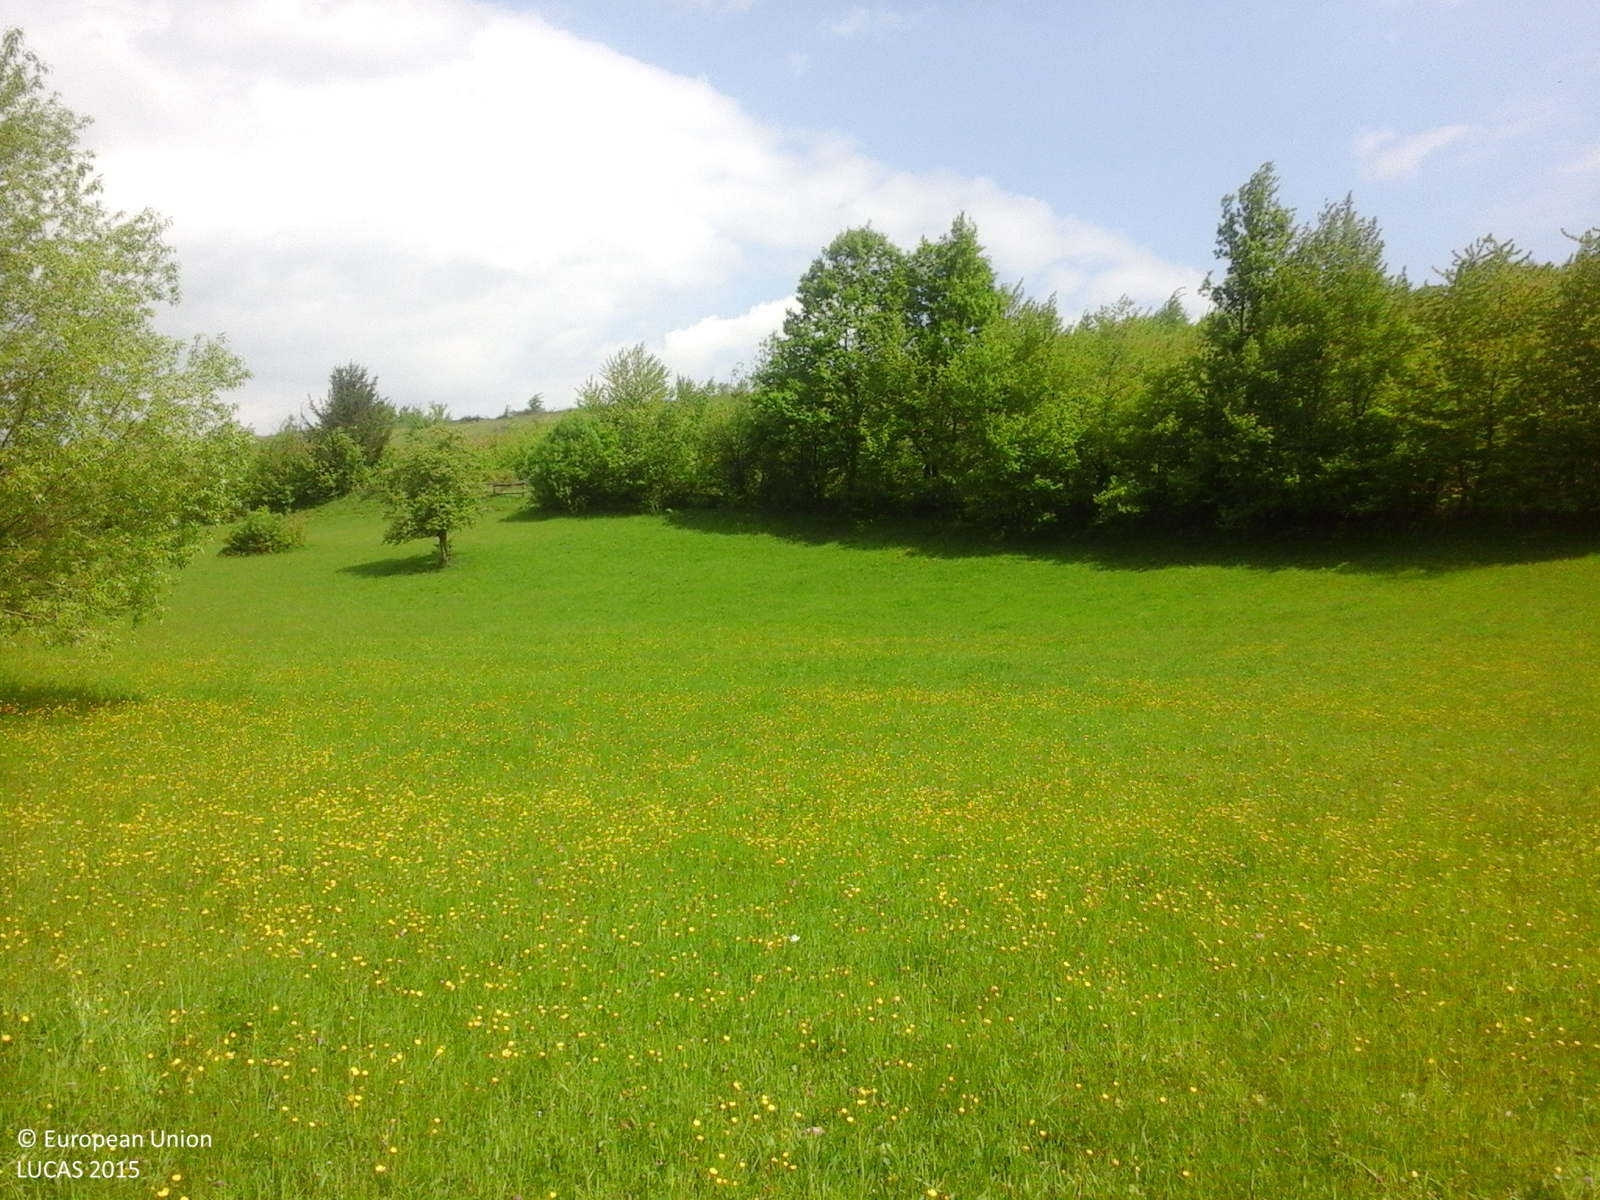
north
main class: Grassland
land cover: Grassland without tree/shrub cover
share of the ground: > 75 %
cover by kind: herbaceous plants 100 %
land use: Agriculture (excluding fallow land and kitchen gardens)
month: May
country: RO
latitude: 45.9761
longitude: 26.2702
